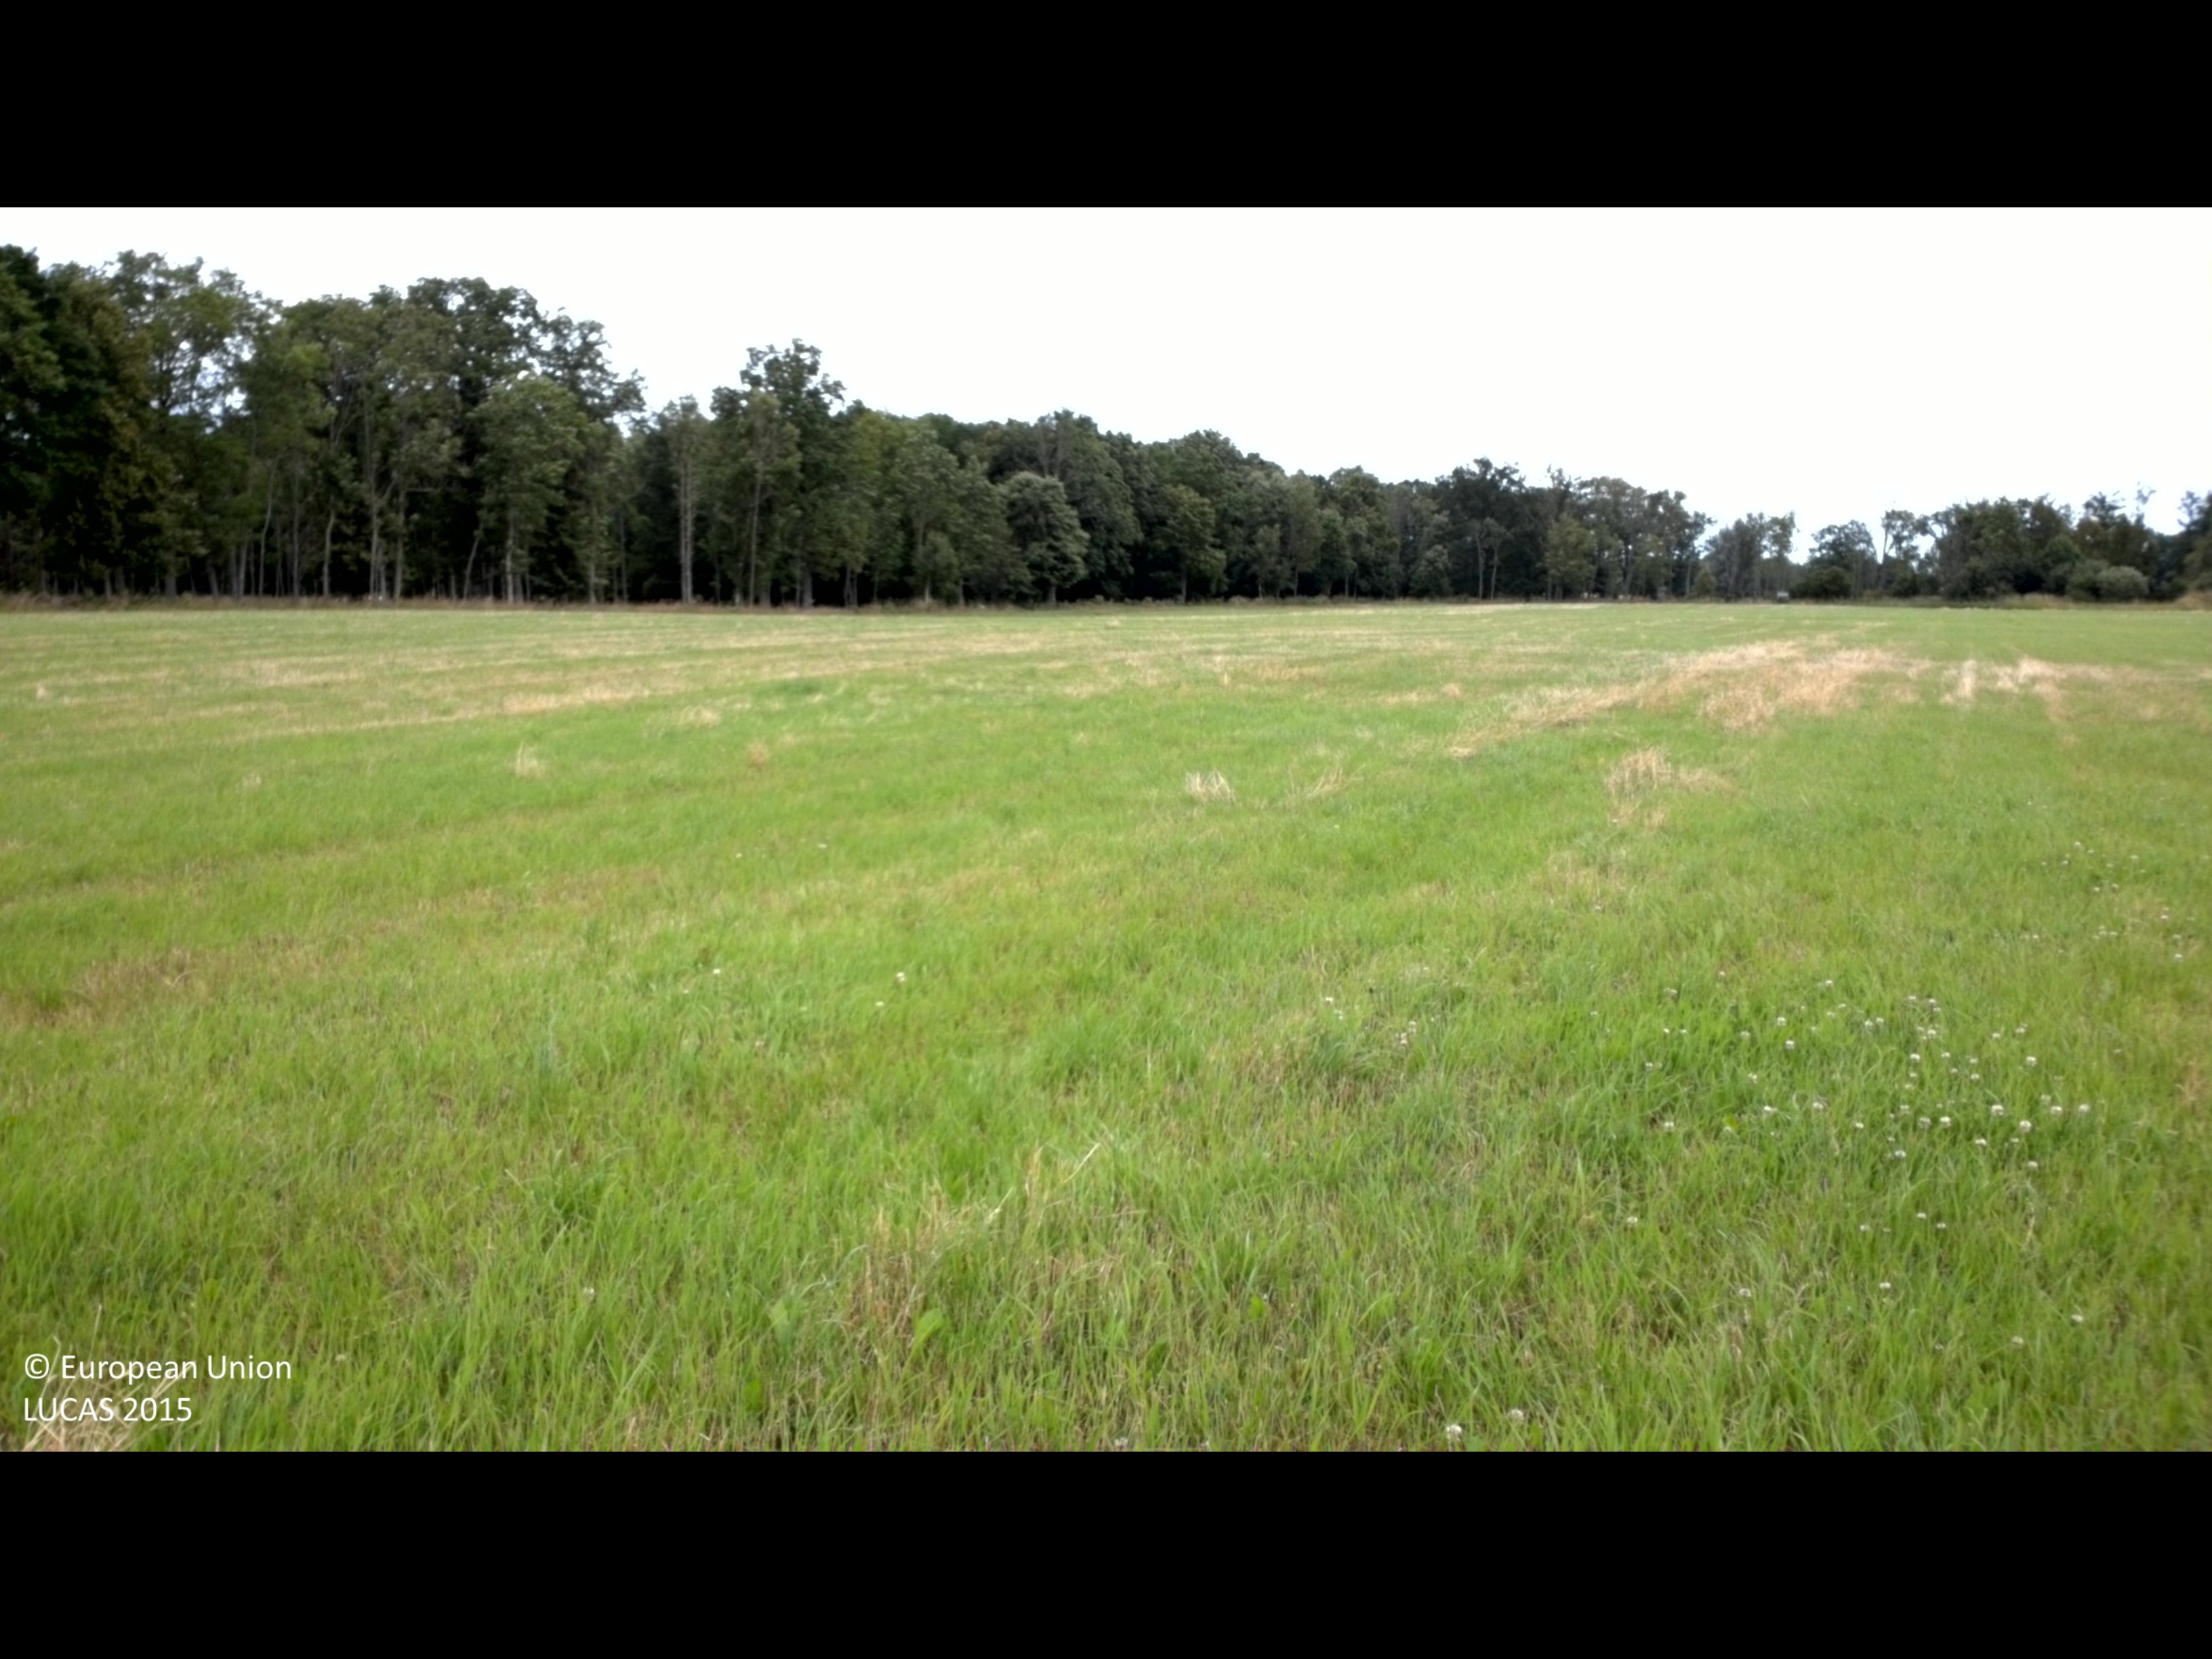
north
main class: Cropland
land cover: Other leguminous and mixtures for fodder
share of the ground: > 75 %
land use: Agriculture (excluding fallow land and kitchen gardens)
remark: Harvested field
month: July
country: SE
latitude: 56.7061
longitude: 16.5514
